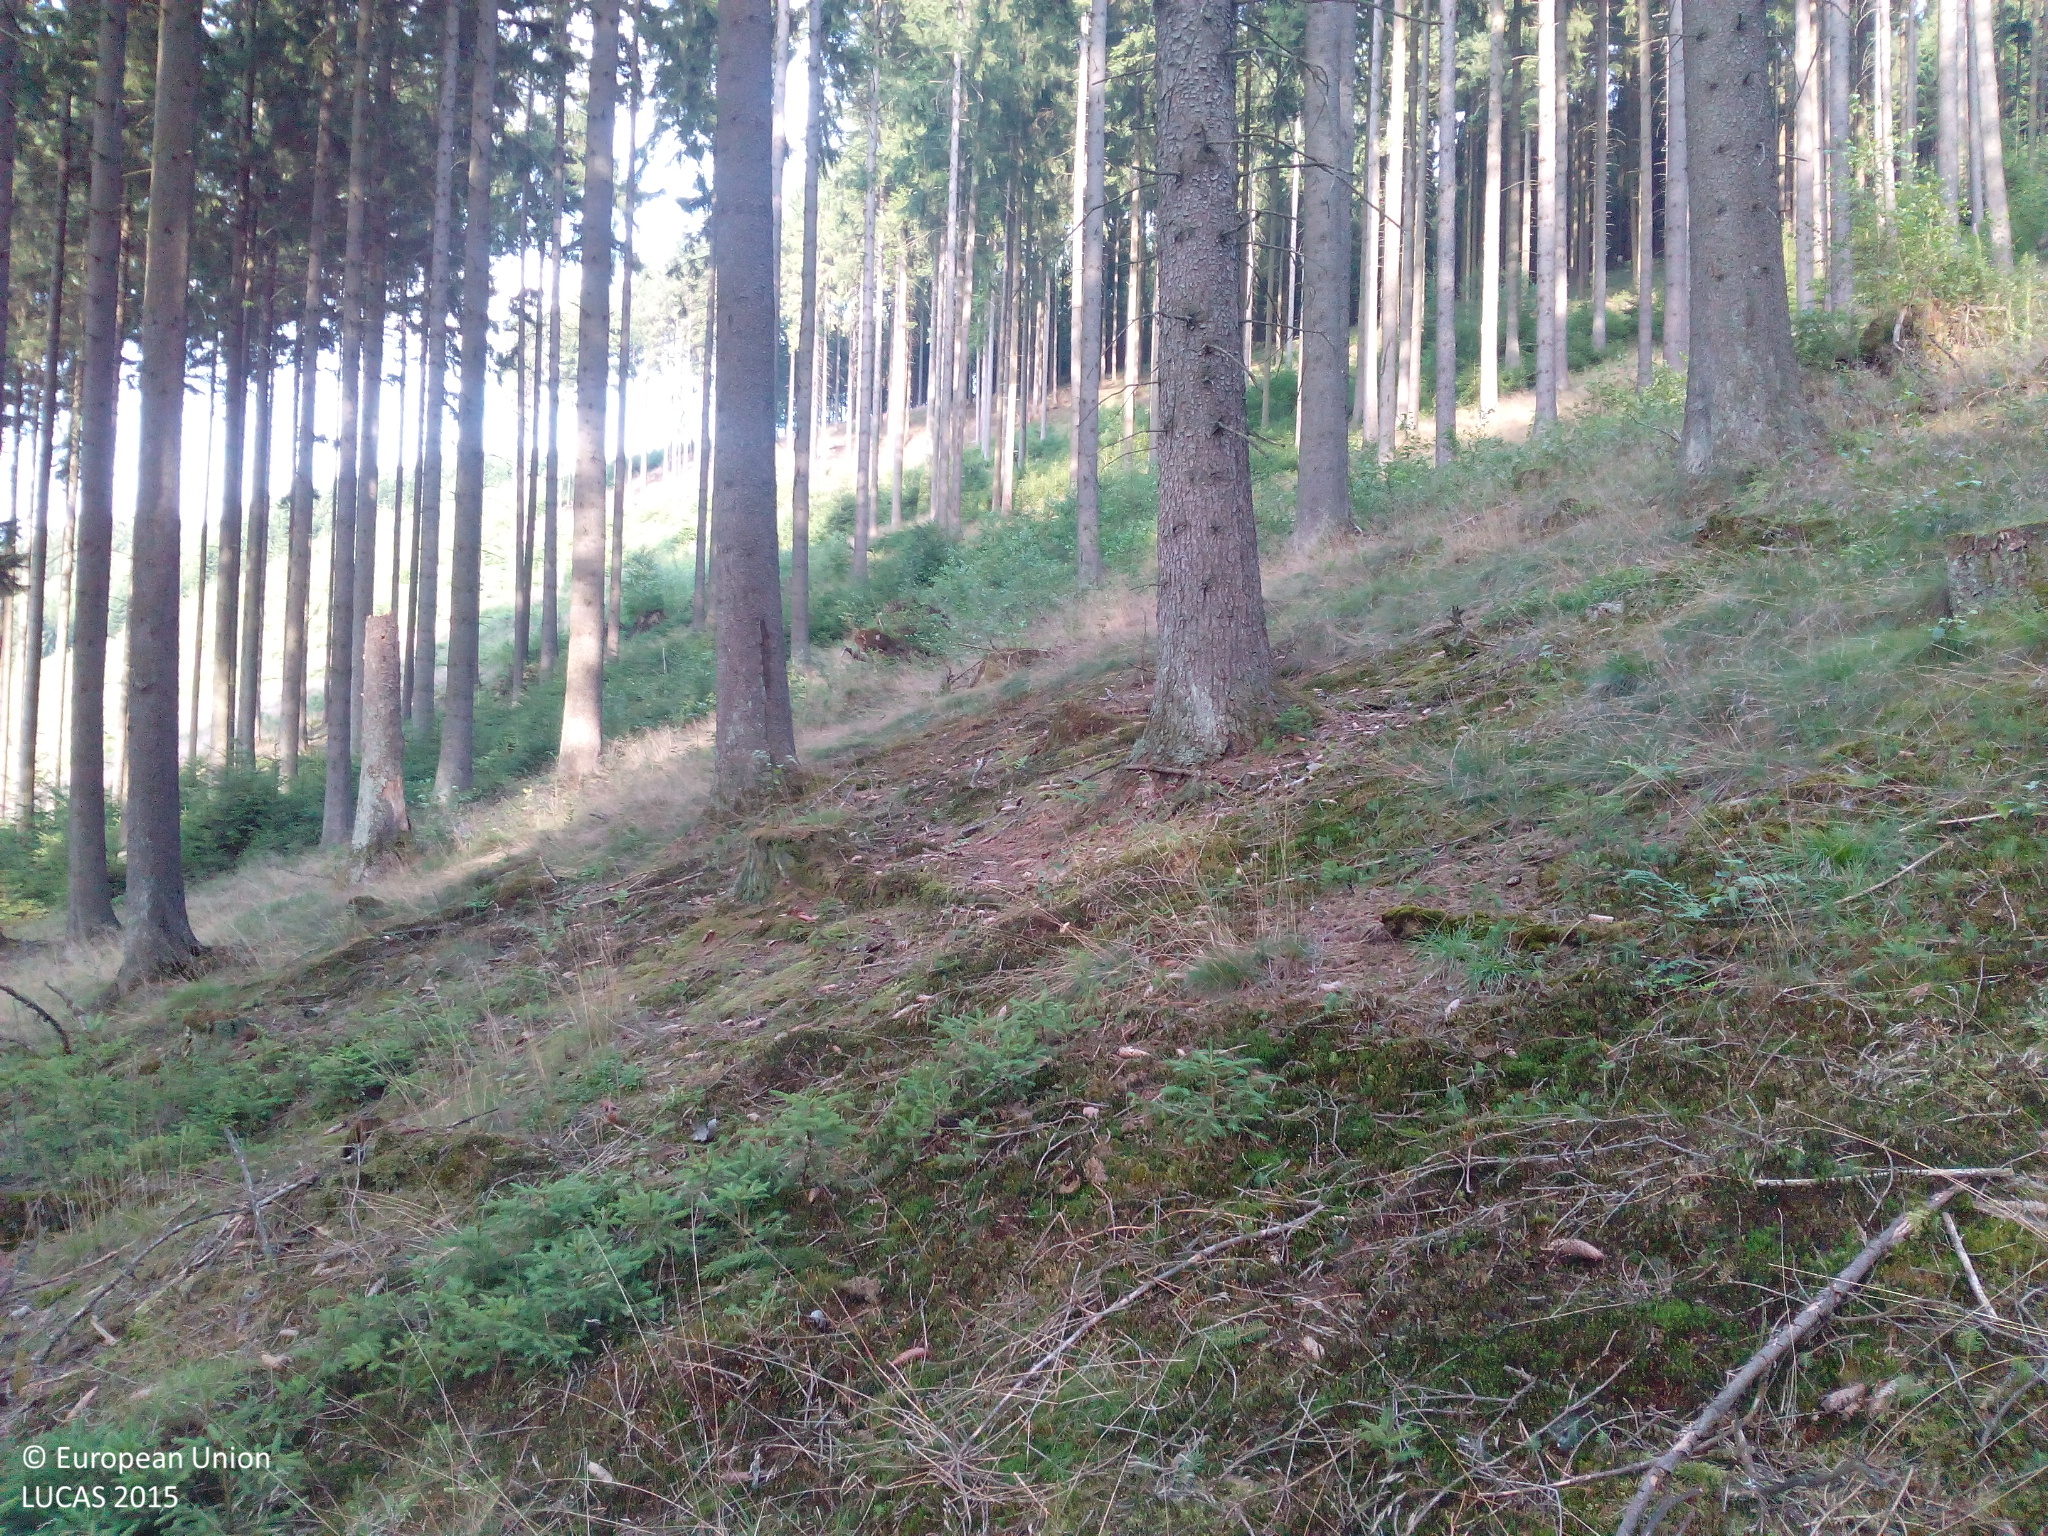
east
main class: Woodland
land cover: Spruce dominated coniferous woodland
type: hemiboreal forest and nemoral coniferous forest and mixed broadleaved-coniferous forest
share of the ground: > 75 %
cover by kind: coniferous forest trees 80 %, herbaceous plants 10 %, lichens and mosses 10 %
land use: Forestry
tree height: > 5 m
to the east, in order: Spruce dominated coniferous woodland; Tracks; Spruce dominated coniferous woodland; Grass margins; Spruce dominated coniferous woodland
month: August
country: DE
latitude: 51.0838
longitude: 7.9875
